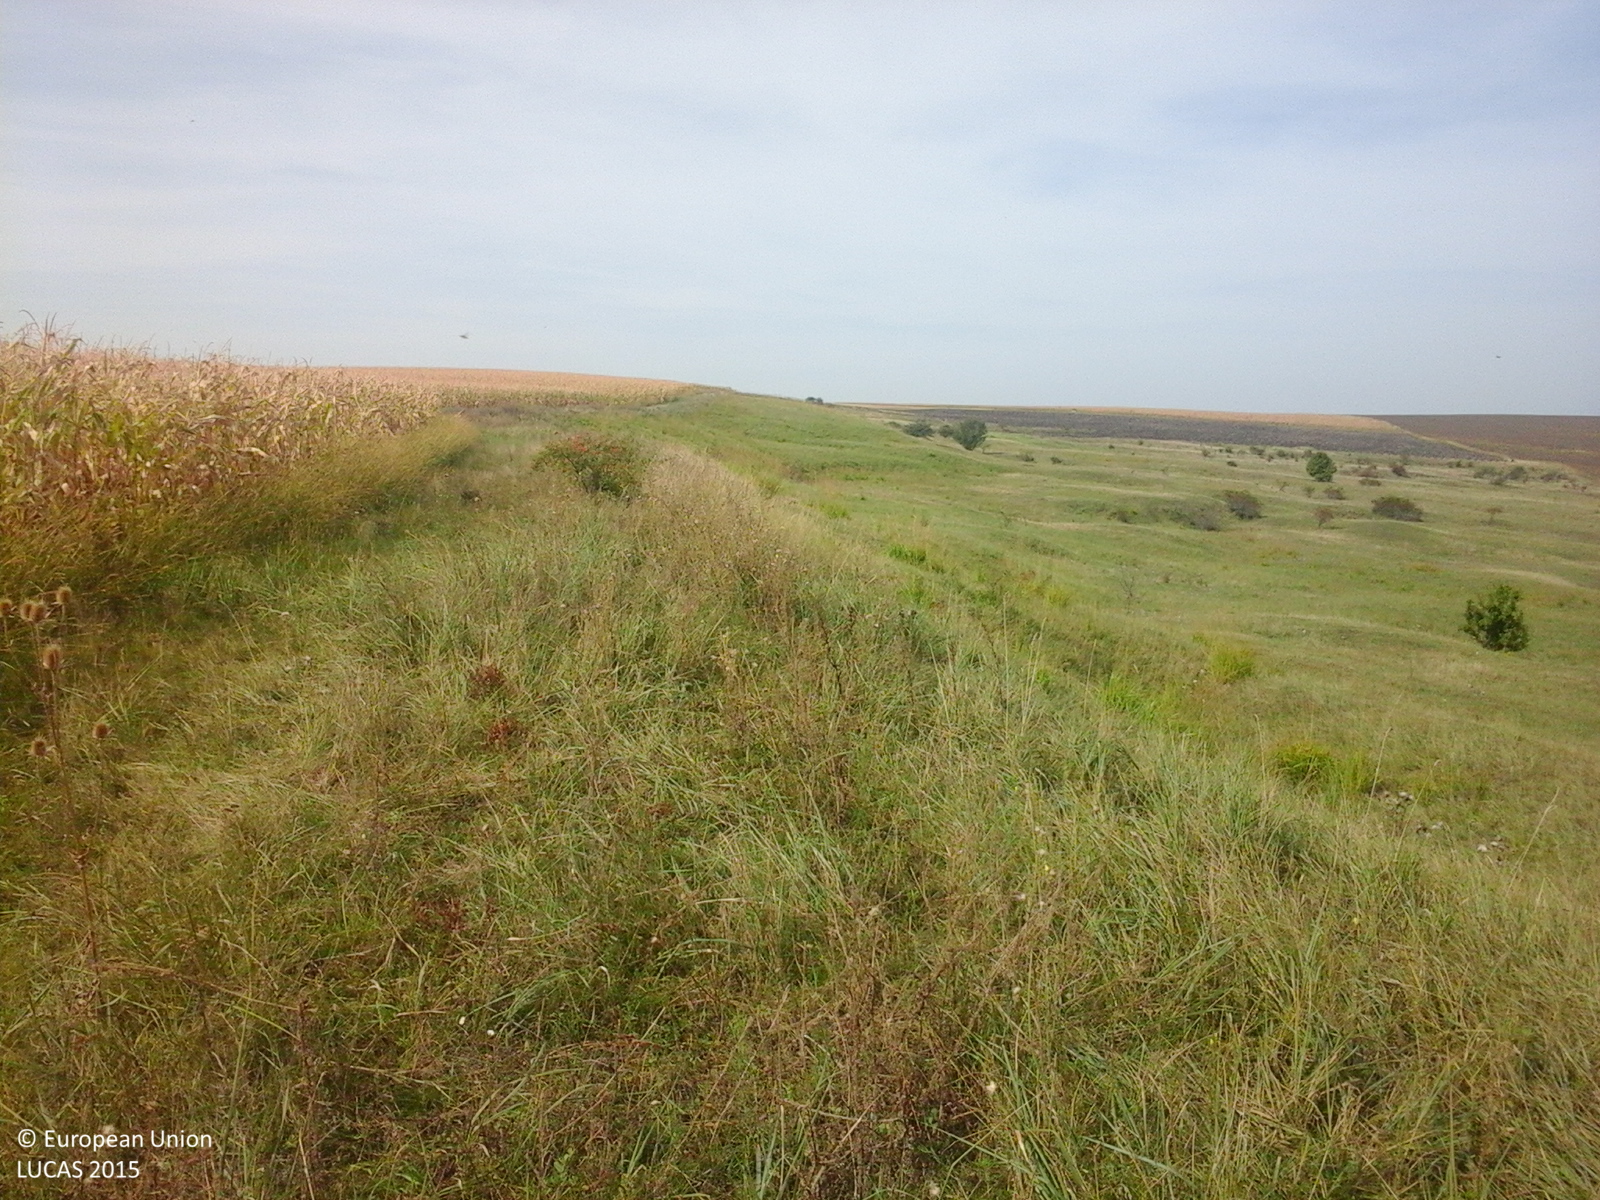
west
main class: Grassland
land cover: Grassland without tree/shrub cover
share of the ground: > 75 %
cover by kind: herbaceous plants 100 %
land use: Agriculture (excluding fallow land and kitchen gardens)
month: September
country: RO
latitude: 46.8411
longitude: 23.6438
